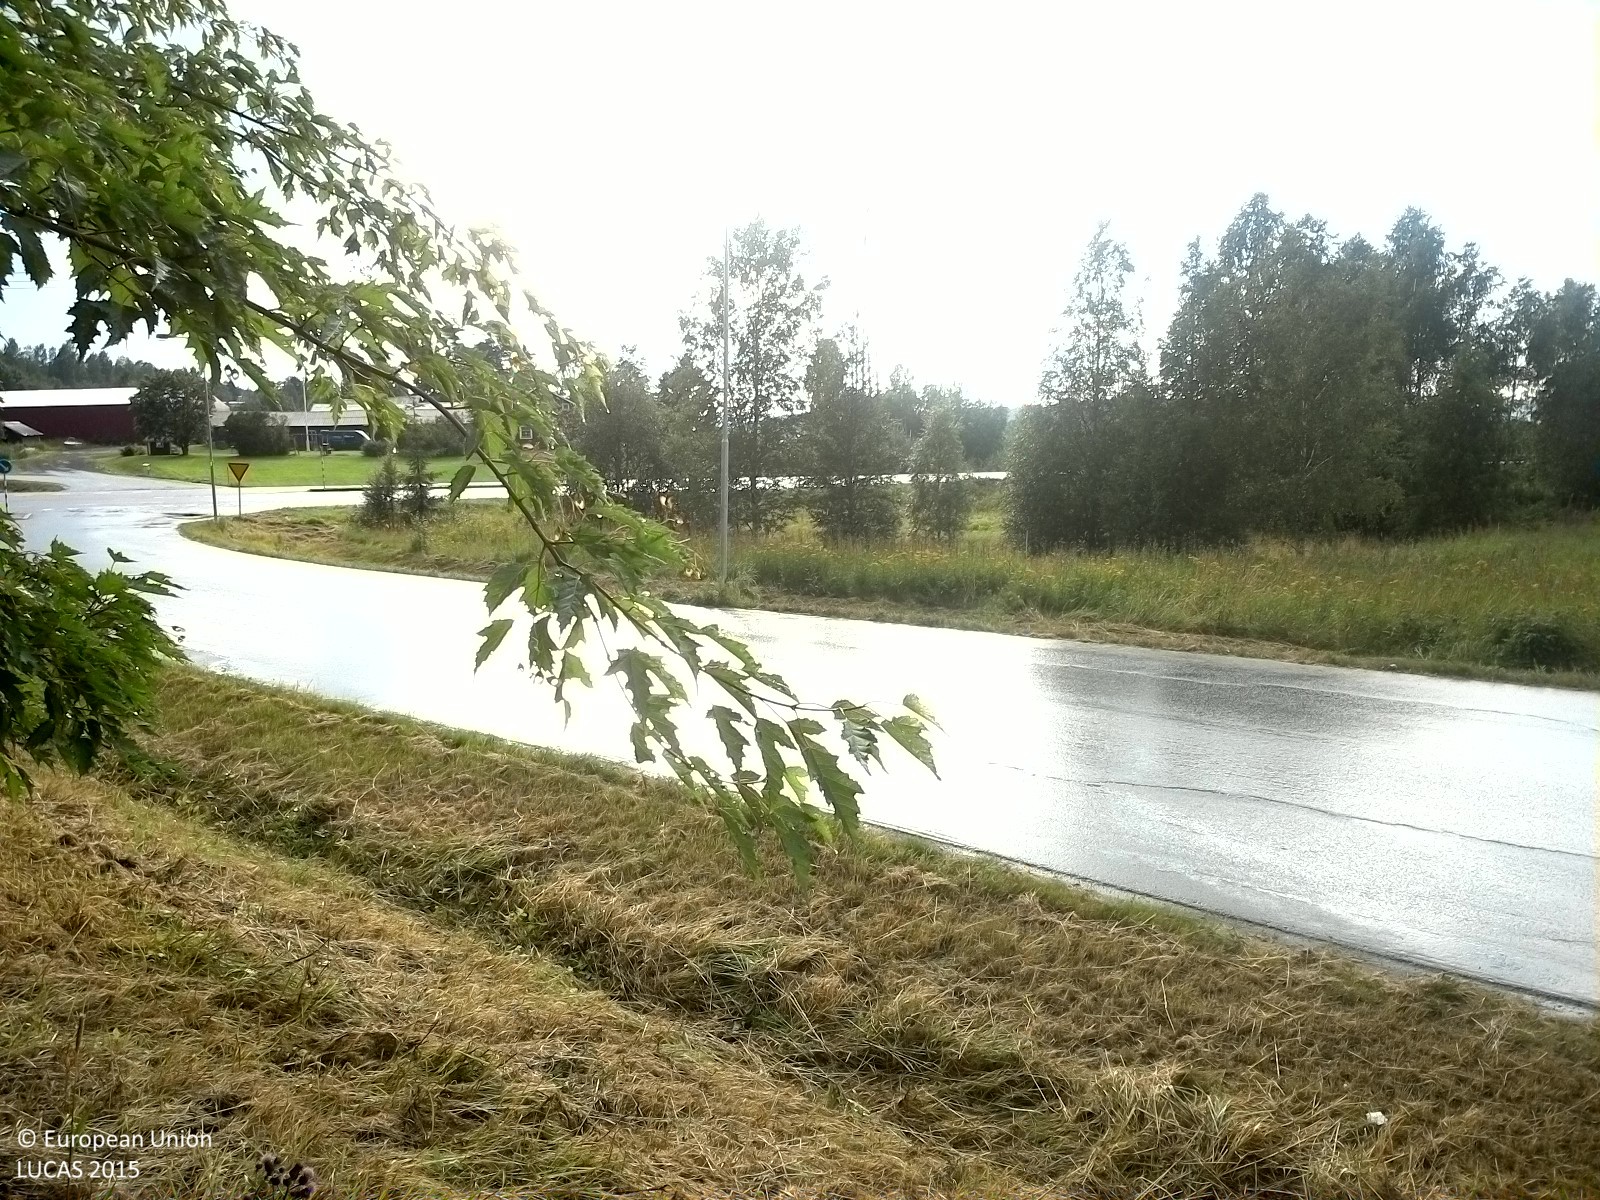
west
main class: Grassland
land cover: Grassland without tree/shrub cover
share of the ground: > 75 %
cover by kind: herbaceous plants 100 %
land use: Abandoned areas
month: August
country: SE
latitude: 62.4021
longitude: 17.2362
